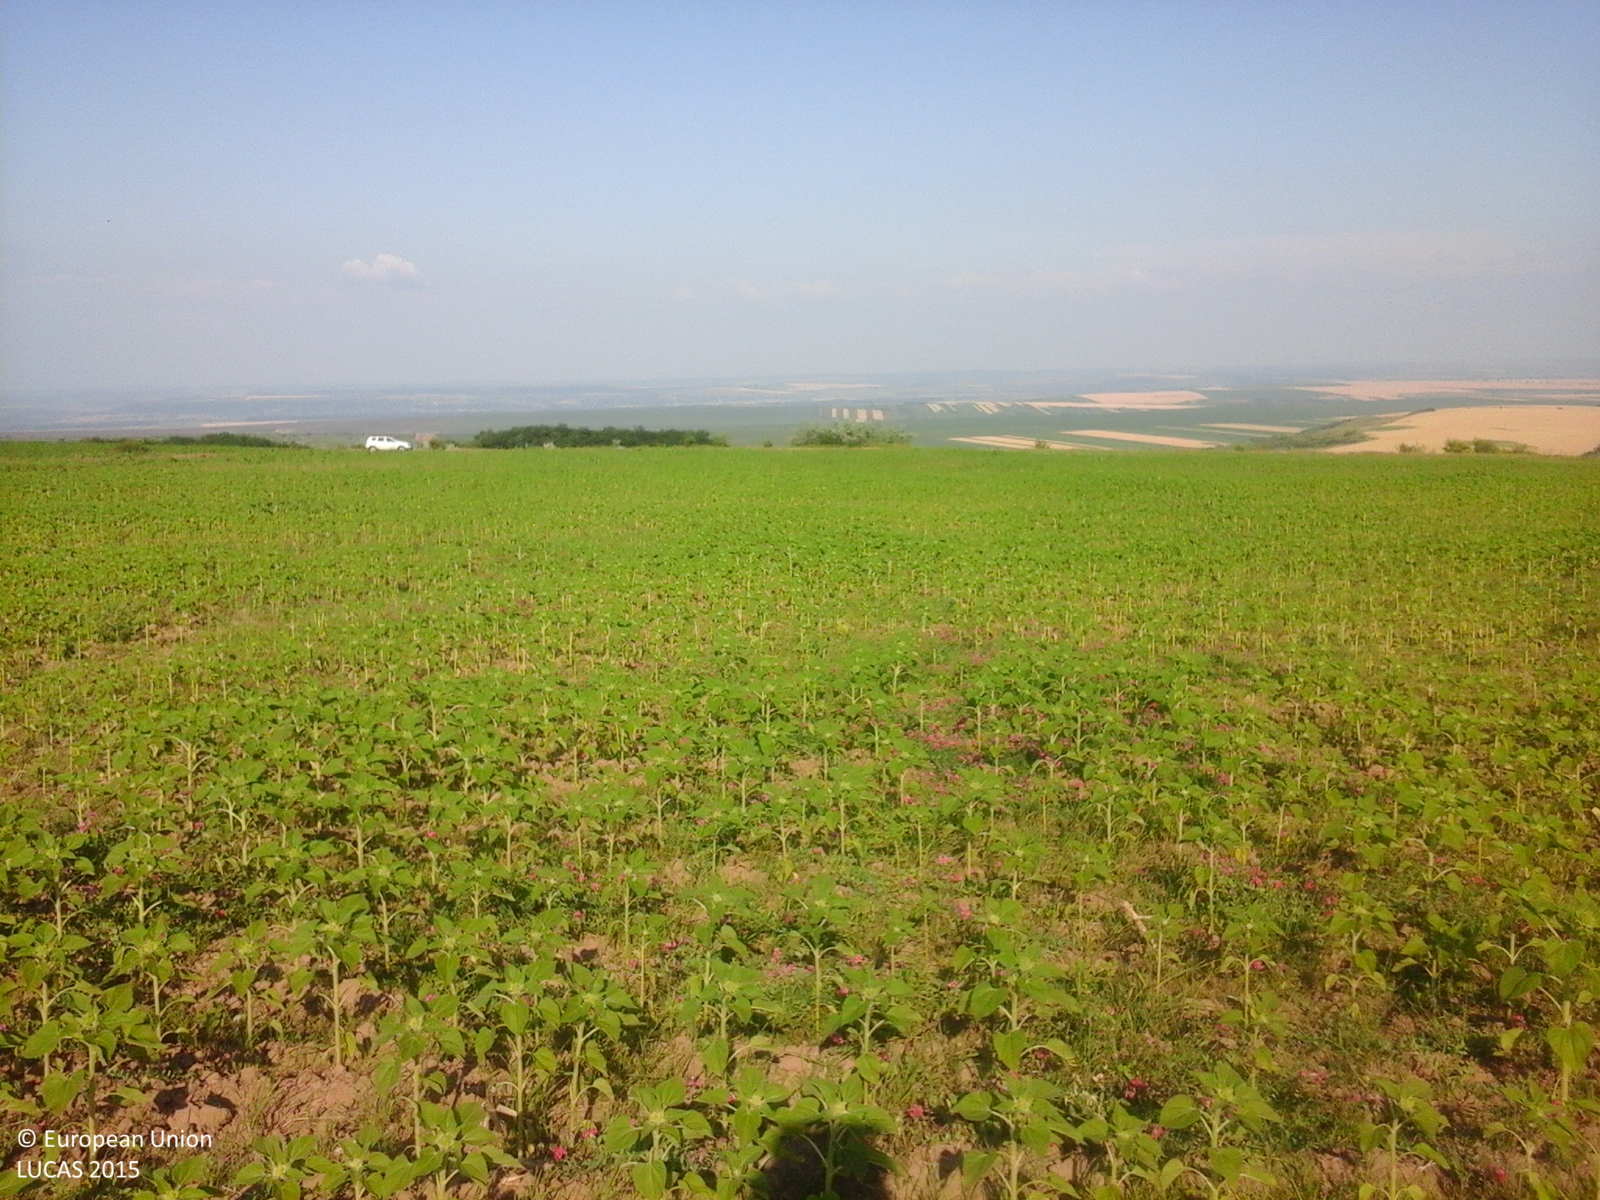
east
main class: Cropland
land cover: Sunflower
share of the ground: 50 - 75 %
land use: Agriculture (excluding fallow land and kitchen gardens)
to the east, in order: Sunflower; Grass margins; Tracks; Spontaneously vegetated surfaces; Maize
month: June
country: RO
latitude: 46.7402
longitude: 28.0203
